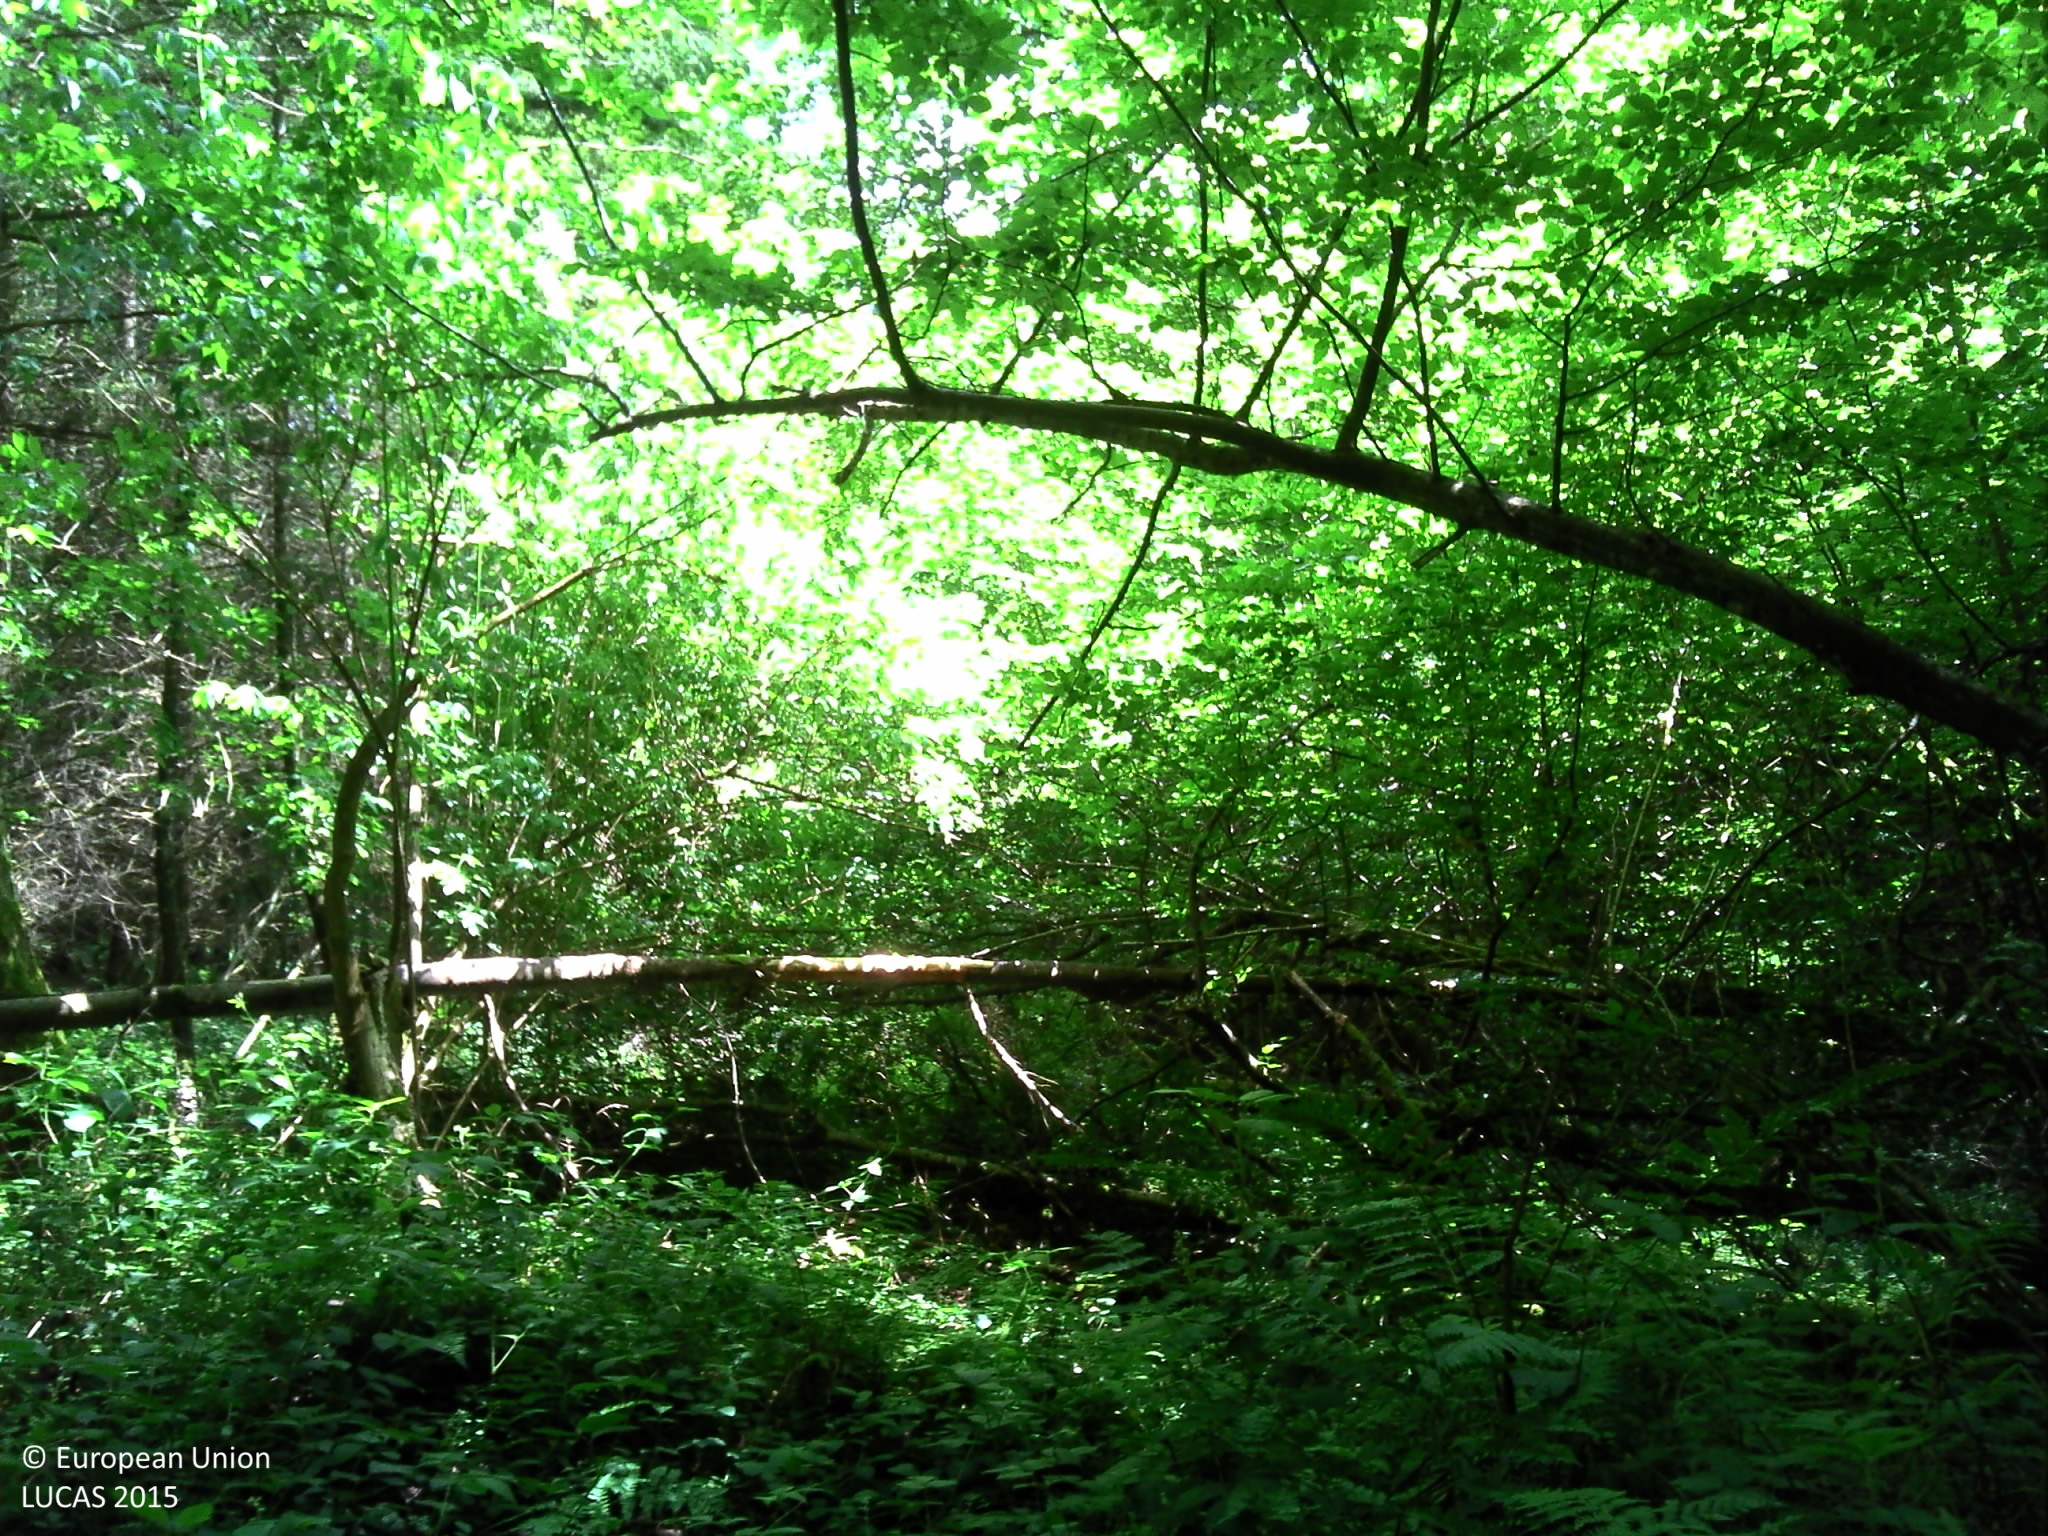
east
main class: Woodland
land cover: Pine dominated mixed woodland
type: acidophilous oak and oak-birch forest
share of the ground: > 75 %
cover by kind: broadleaved forest trees 70 %, coniferous forest trees 25 %, herbaceous plants 5 %
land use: Forestry
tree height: > 5 m
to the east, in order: Pine dominated mixed woodland; Rivers and streams; Pine dominated mixed woodland; Rivers and streams; Pine dominated mixed woodland
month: June
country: FR
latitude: 46.1591
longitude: 3.0184
